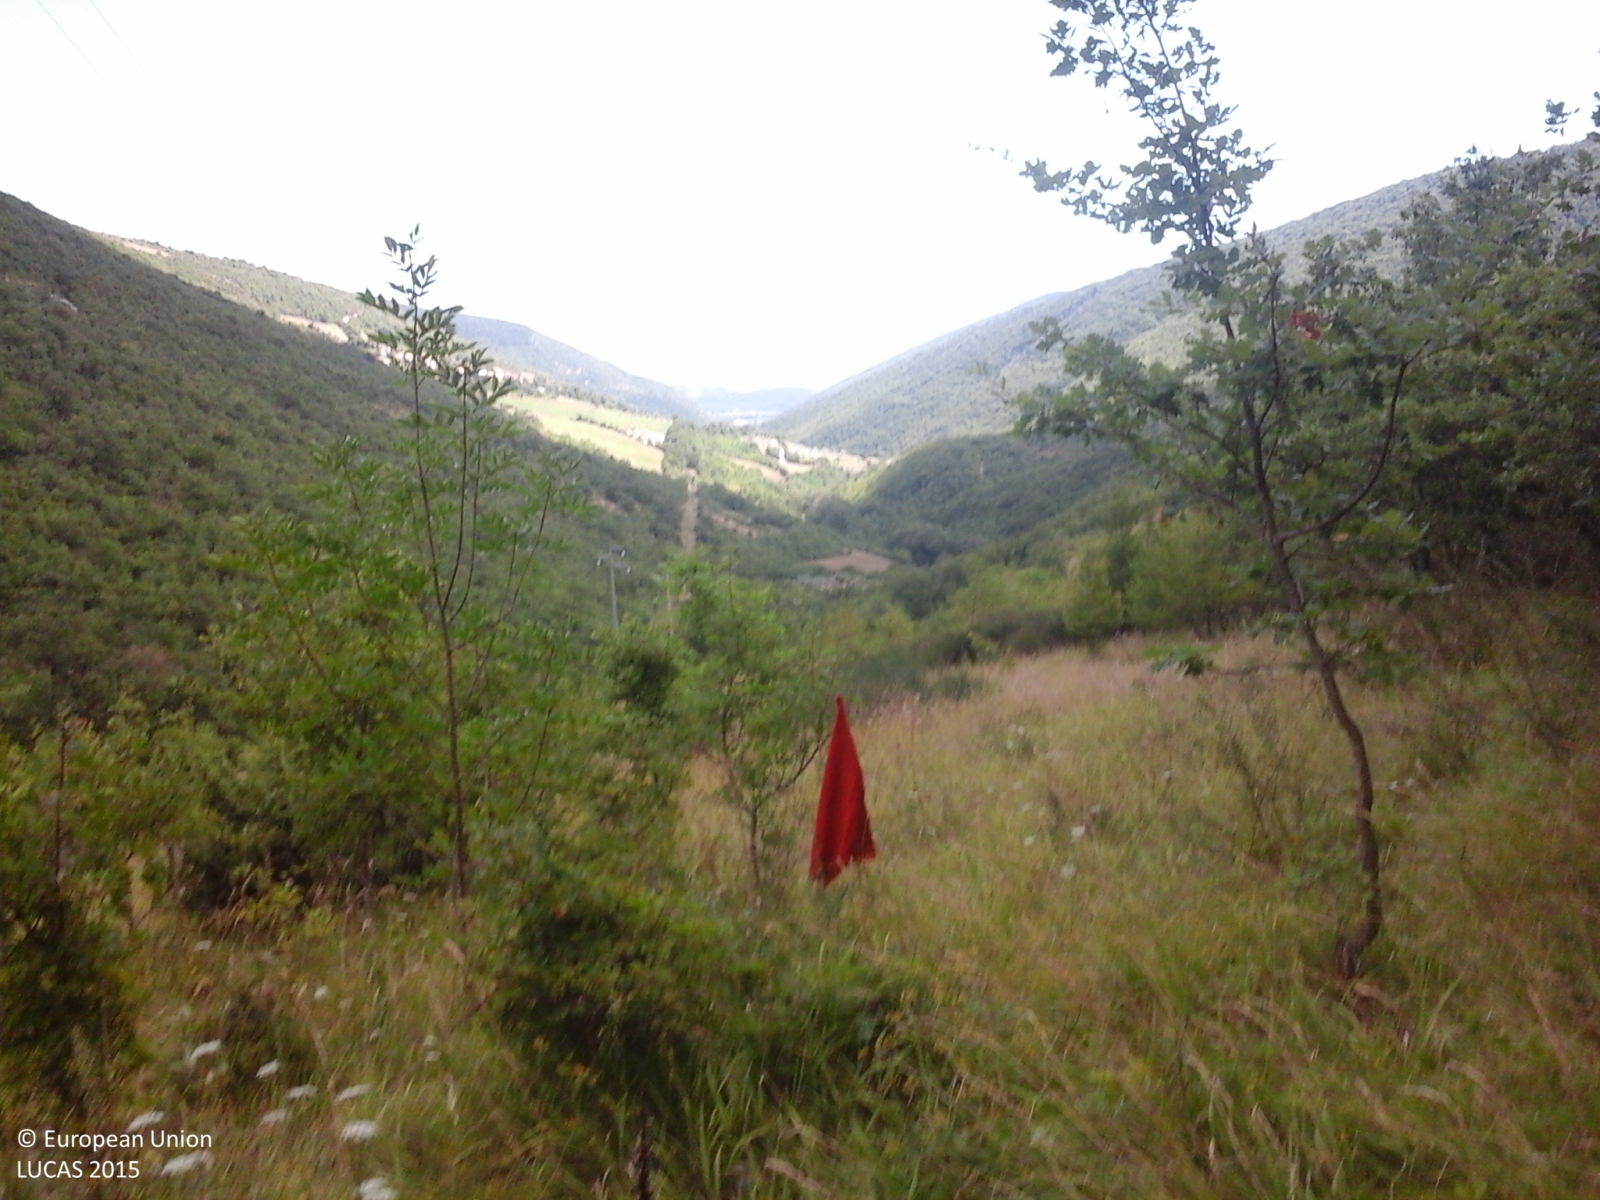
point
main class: Shrubland
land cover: Shrubland with sparse tree cover
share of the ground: > 75 %
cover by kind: herbaceous plants 55 %, shrubs 40 %, broadleaved forest trees 5 %
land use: Agriculture (excluding fallow land and kitchen gardens)
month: August
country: IT
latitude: 43.1839
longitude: 13.1289
